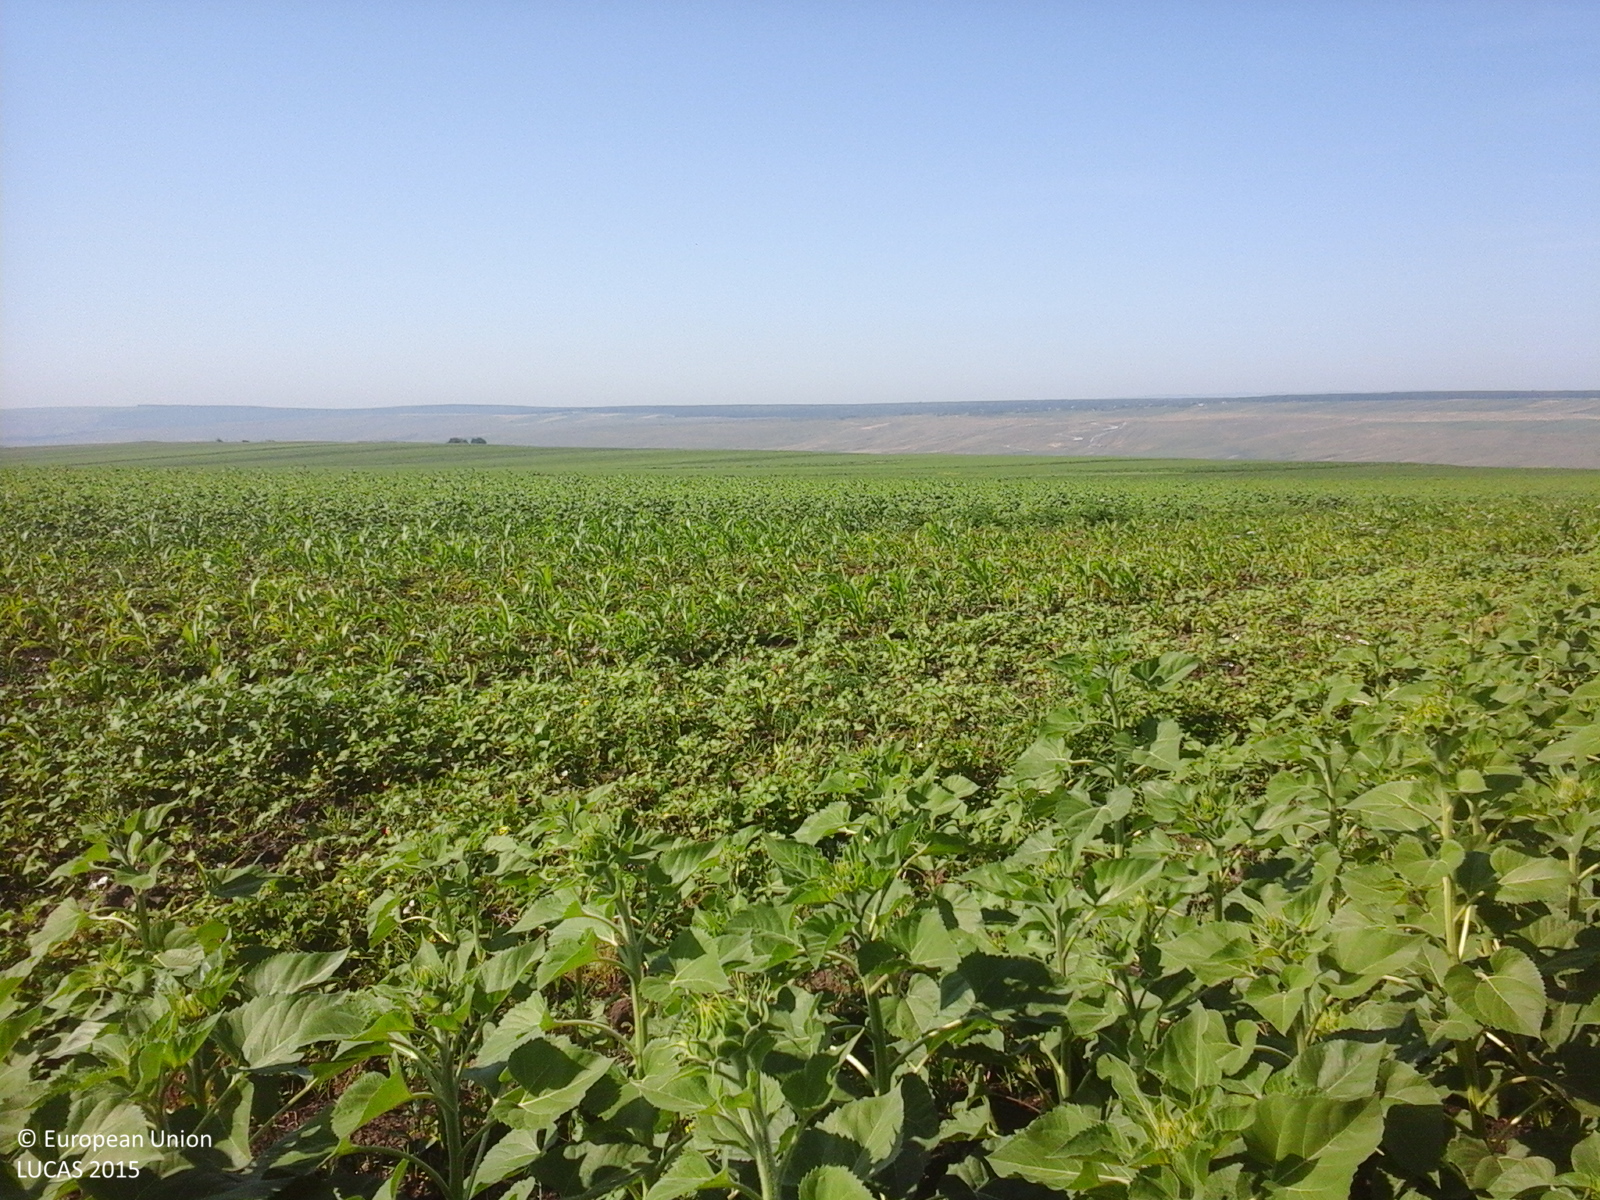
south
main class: Cropland
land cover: Sunflower
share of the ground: > 75 %
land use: Agriculture (excluding fallow land and kitchen gardens)
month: June
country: RO
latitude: 47.7235
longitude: 27.0783
